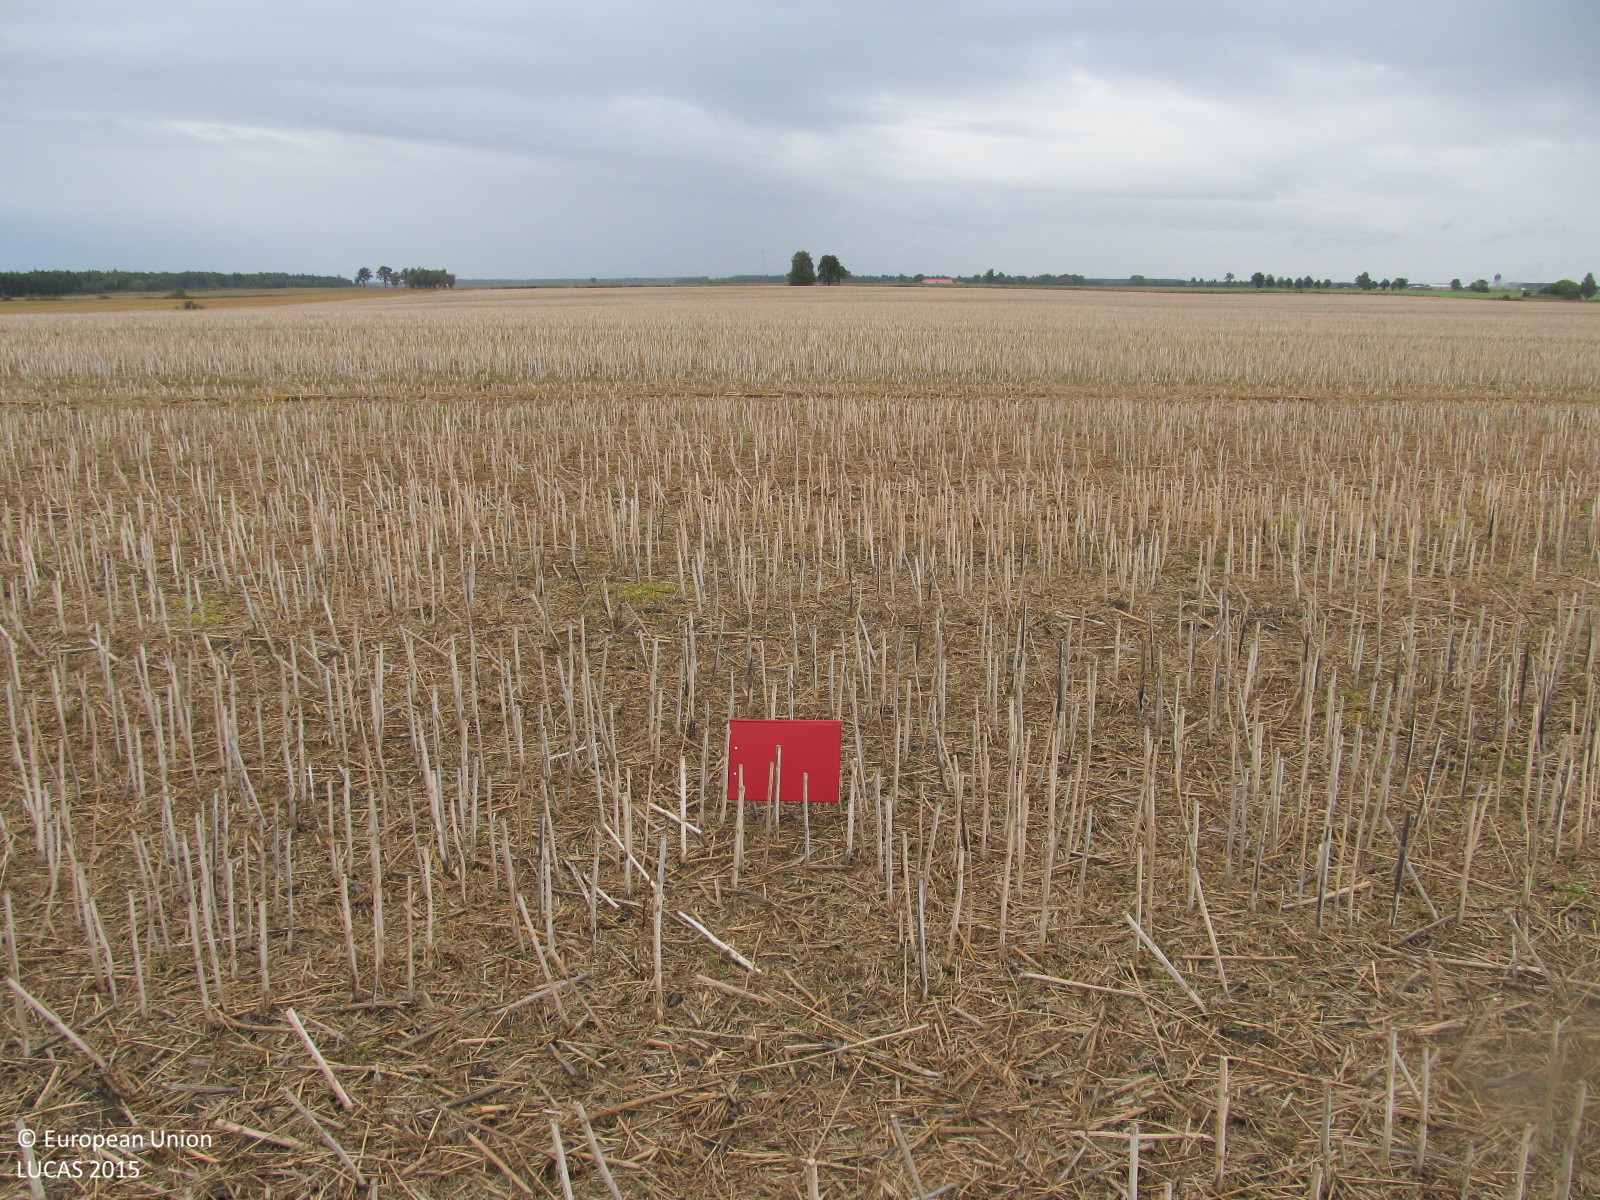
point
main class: Cropland
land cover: Rape and turnip rape
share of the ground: > 75 %
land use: Agriculture (excluding fallow land and kitchen gardens)
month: September
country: LT
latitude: 56.1034
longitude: 23.2067
